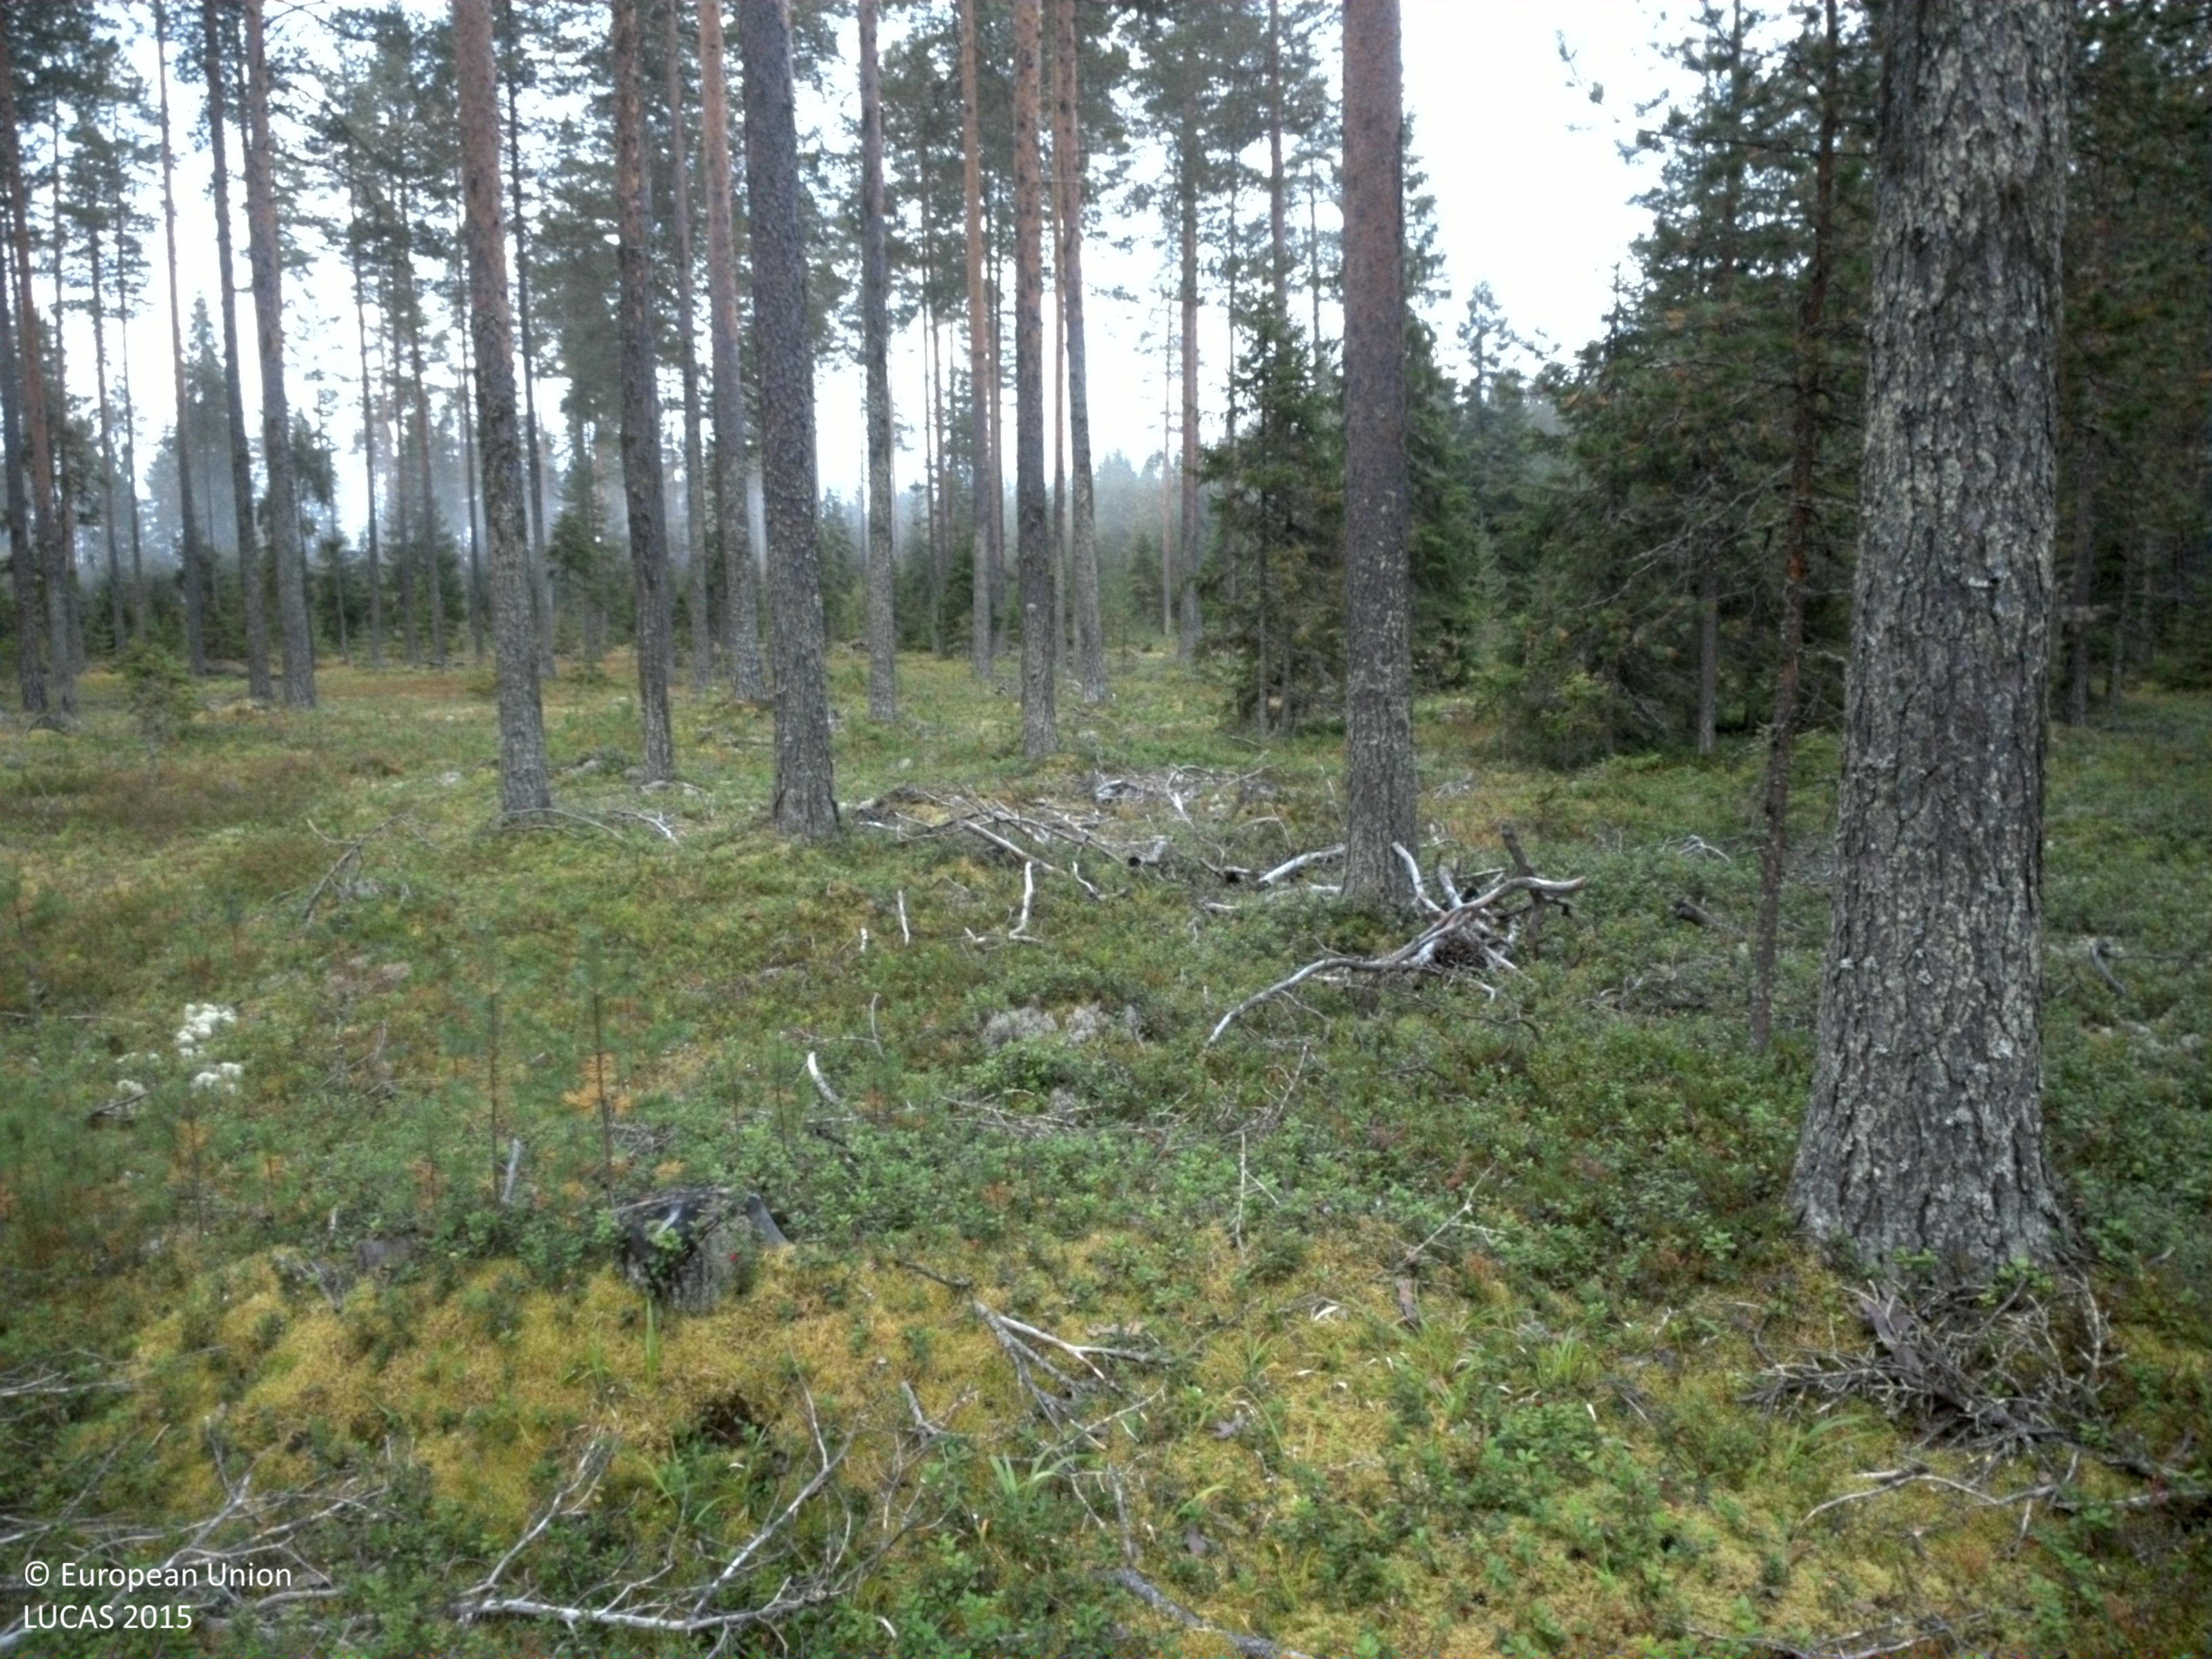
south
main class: Woodland
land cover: Pine dominated coniferous woodland
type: boreal forest
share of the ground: 25 - 50 %
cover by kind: shrubs 60 %, coniferous forest trees 30 %, lichens and mosses 10 %
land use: Forestry
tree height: > 5 m
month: September
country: SE
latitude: 65.5683
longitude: 22.0477
